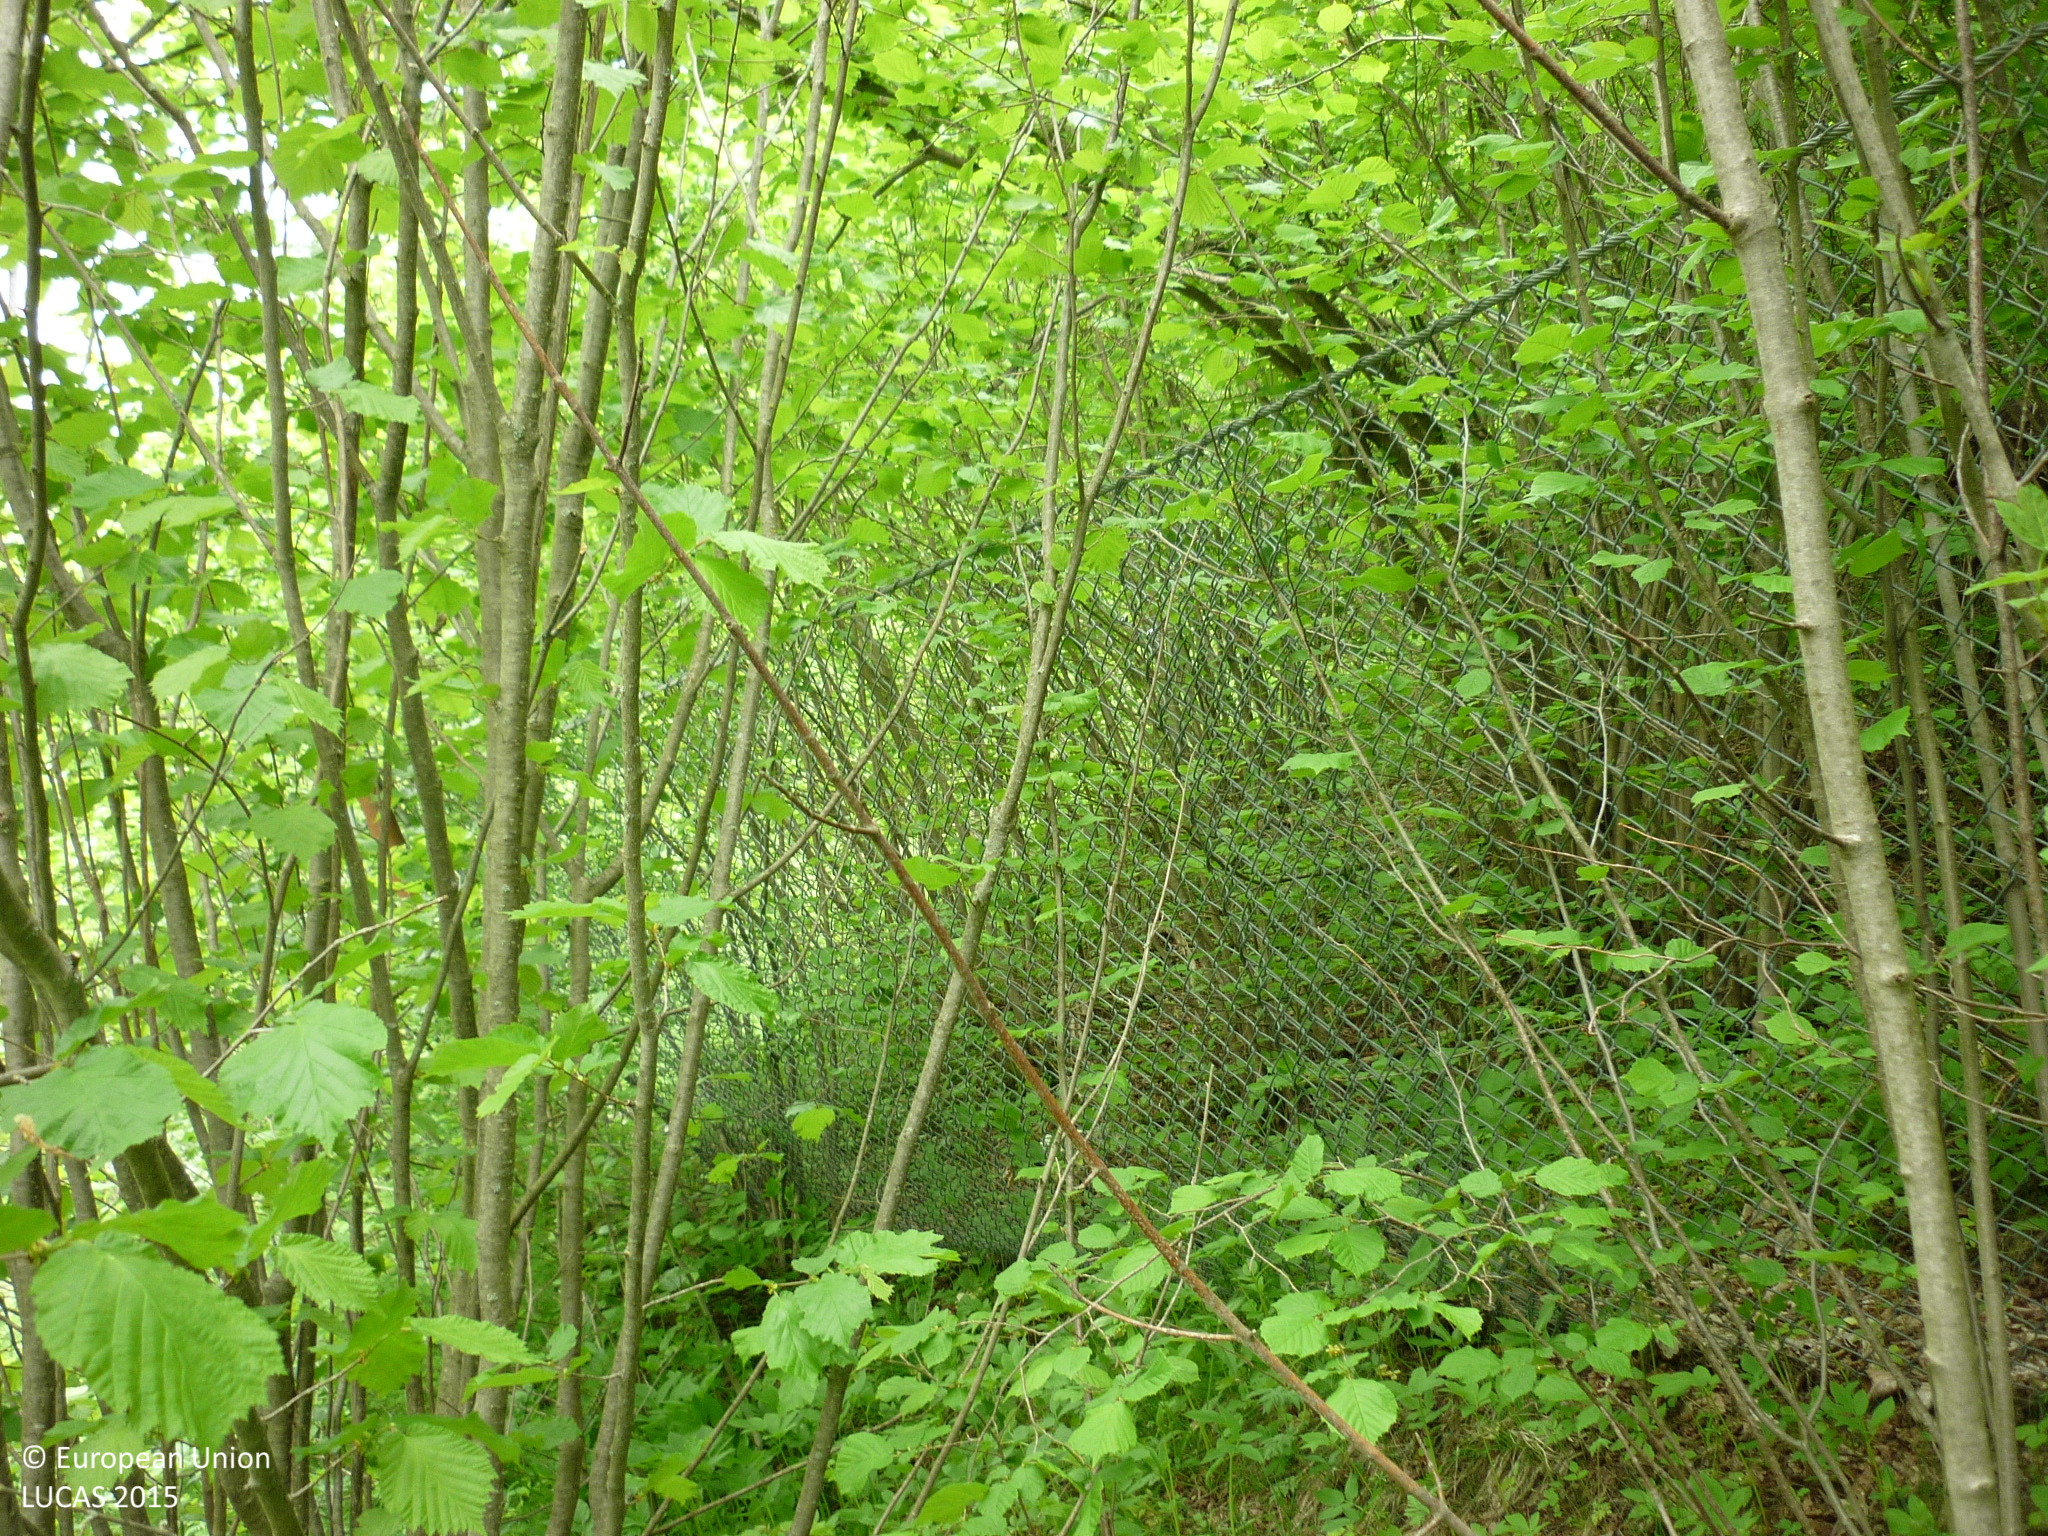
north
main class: Shrubland
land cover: Shrubland with sparse tree cover
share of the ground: 50 - 75 %
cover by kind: shrubs 50 %, herbaceous plants 25 %, consolidated bare surface 10 %, unconsolidated bare surface 10 %, coniferous forest trees 5 %
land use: Semi-natural and natural areas not in use
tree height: > 5 m
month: June
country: AT
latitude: 47.3234
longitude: 14.4312
